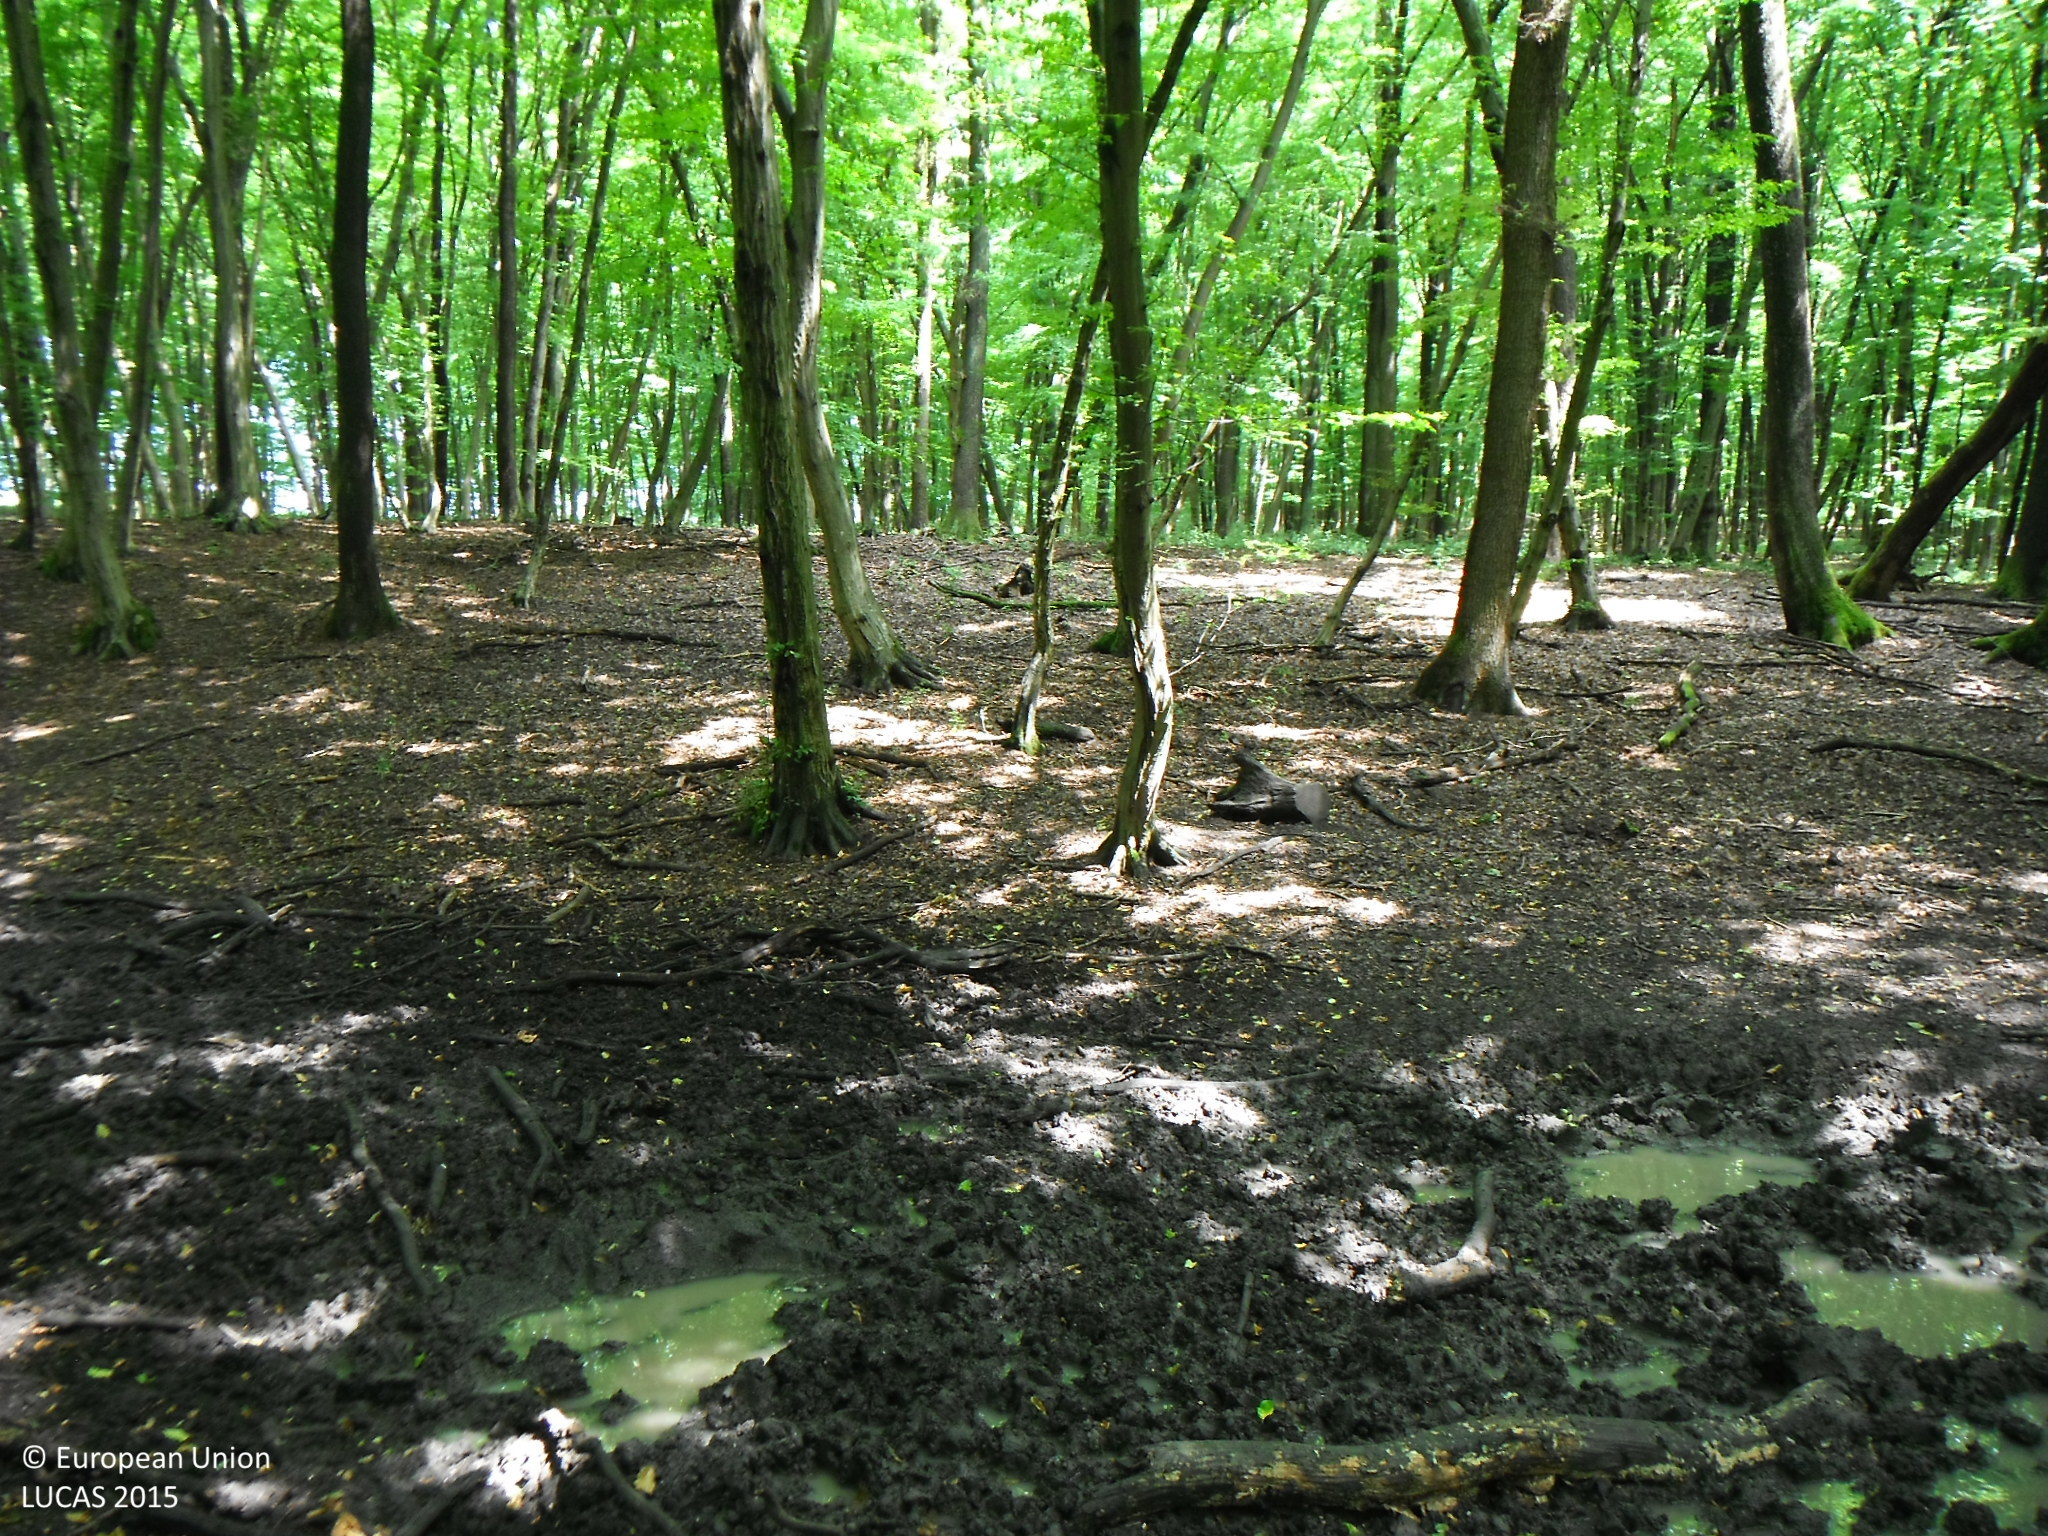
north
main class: Woodland
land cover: Broadleaved woodland
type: mesophytic deciduous forest
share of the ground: > 75 %
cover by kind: broadleaved forest trees 100 %
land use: Forestry
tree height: > 5 m
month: July
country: SK
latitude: 48.7234
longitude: 21.3694
